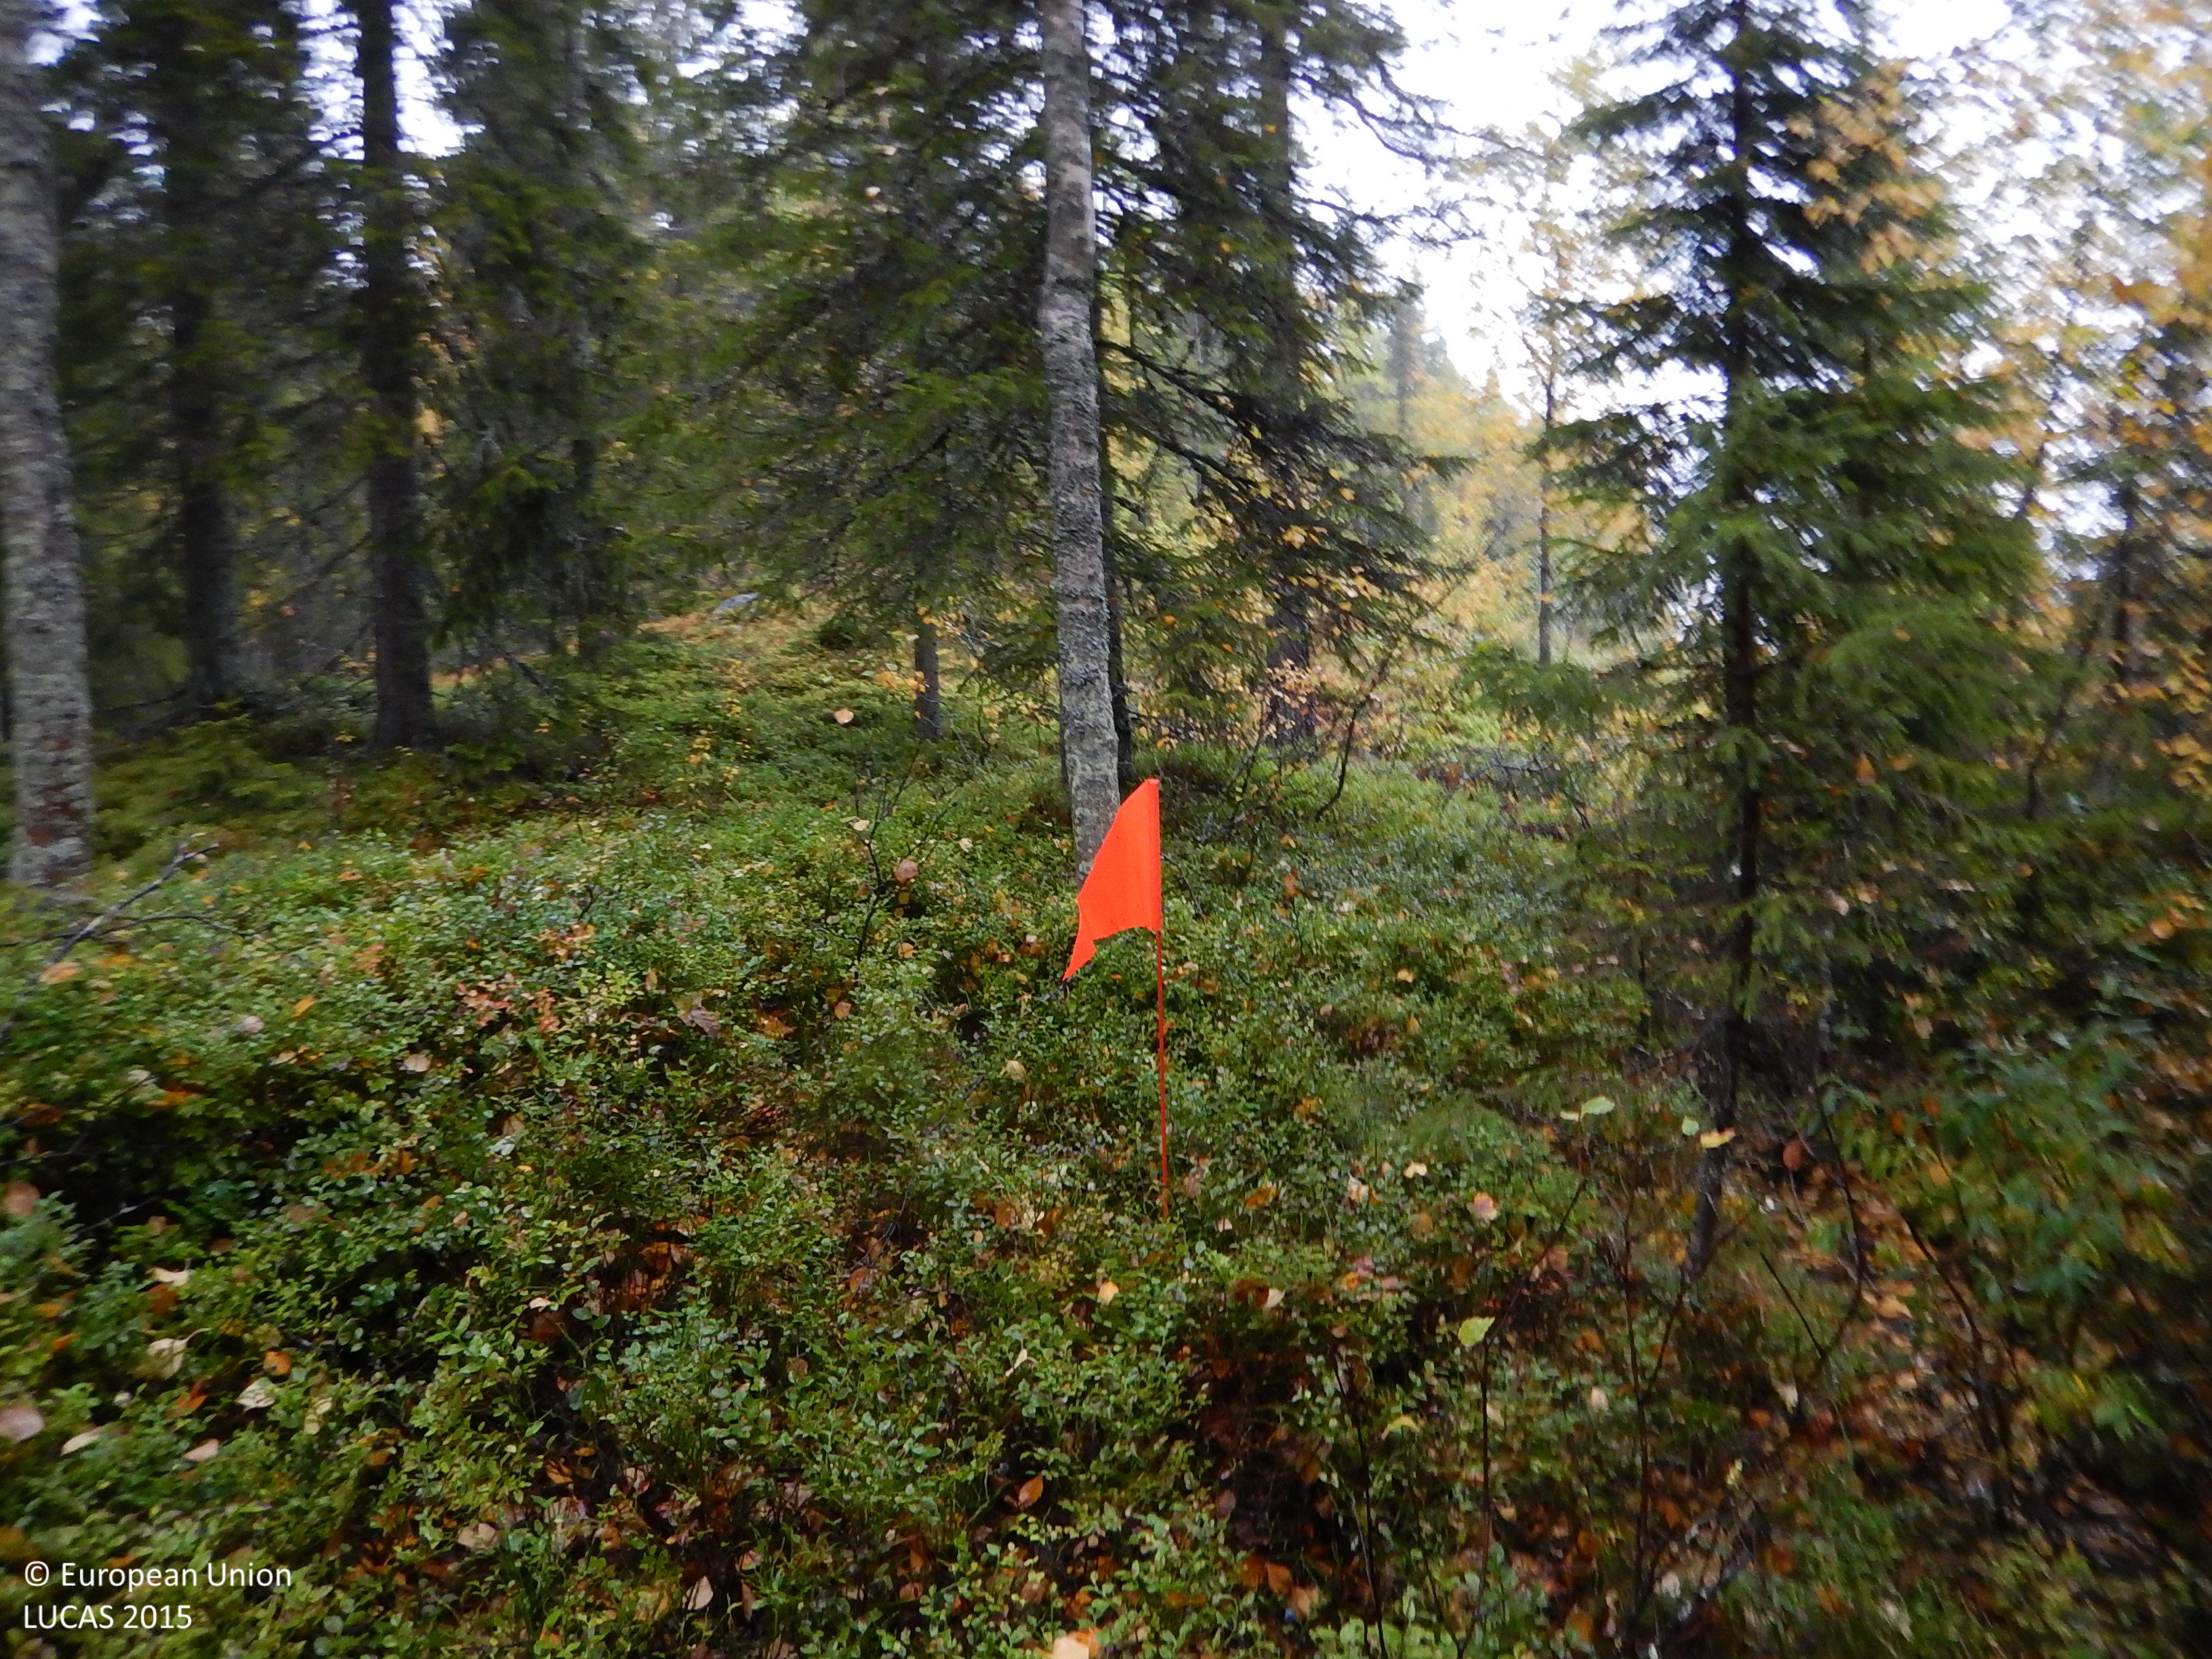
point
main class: Woodland
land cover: Spruce dominated mixed woodland
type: boreal forest
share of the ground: 25 - 50 %
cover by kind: coniferous forest trees 30 %, herbaceous plants 20 %, lichens and mosses 20 %, broadleaved forest trees 15 %, shrubs 15 %
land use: Forestry
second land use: Amenities, museums, leisure
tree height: > 5 m
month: September
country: SE
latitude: 65.0324
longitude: 19.0314
